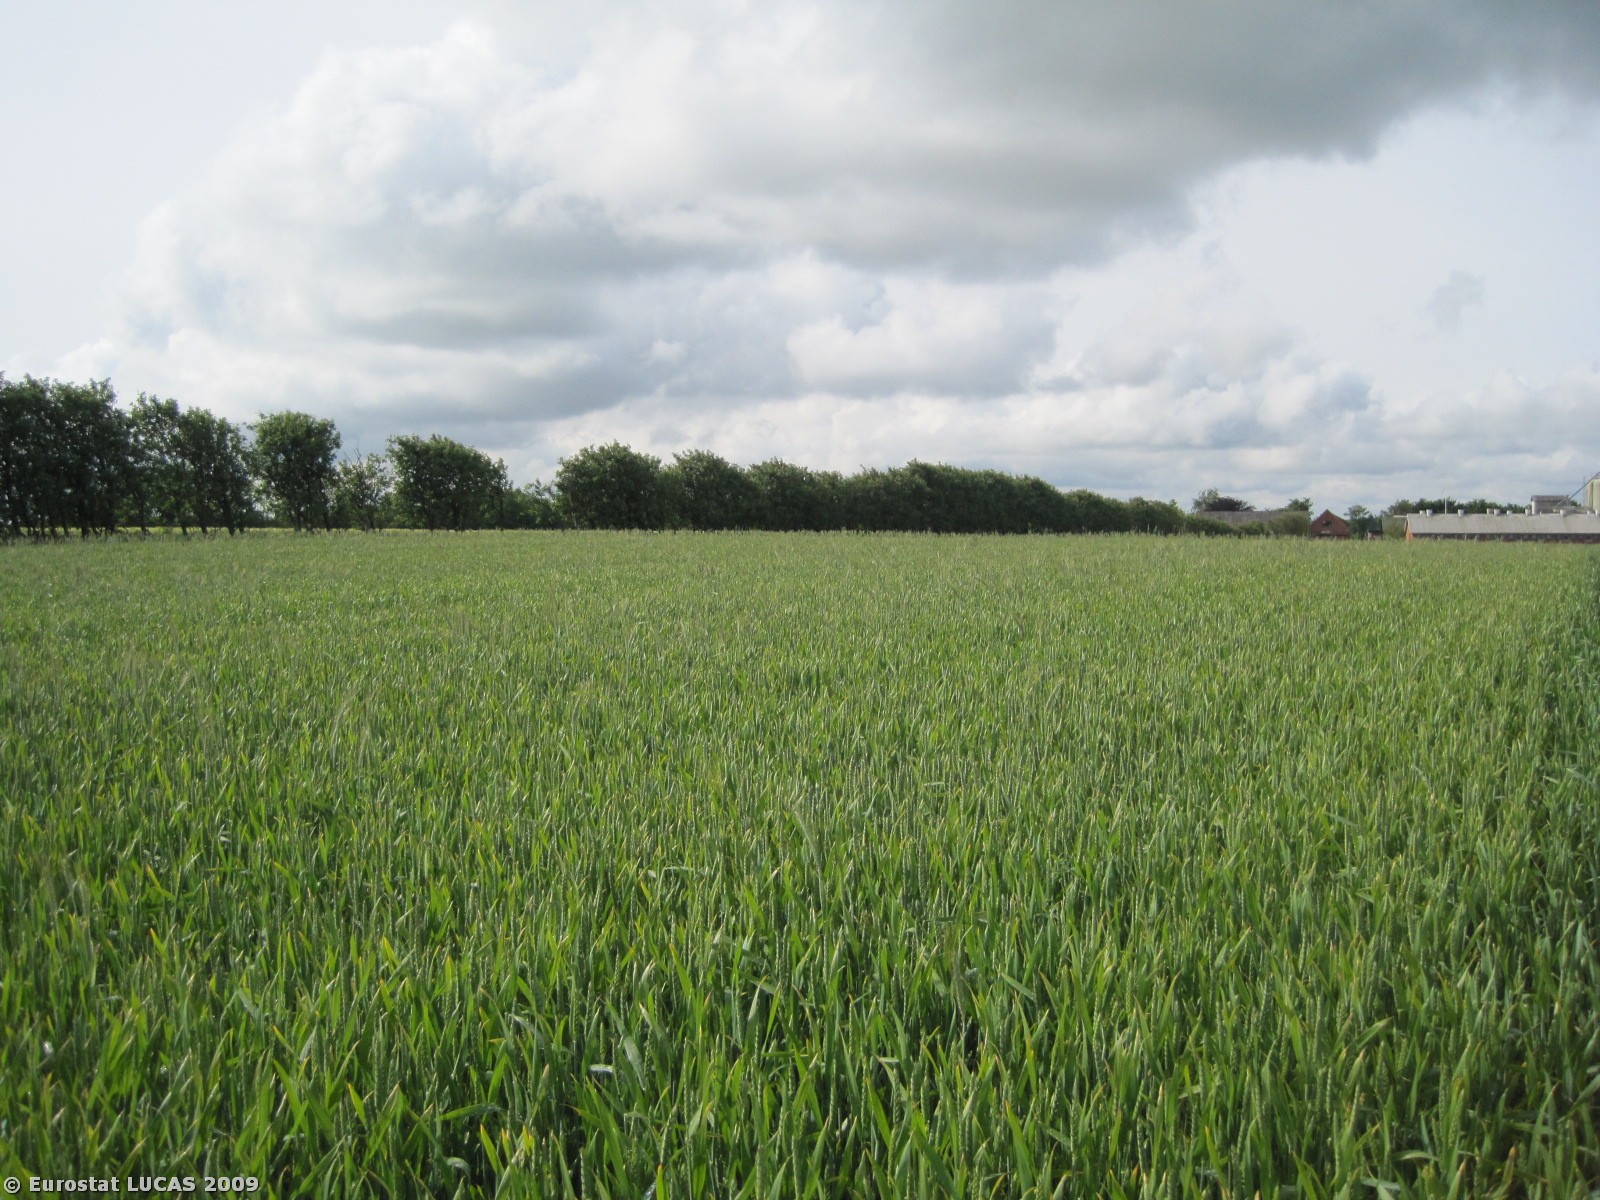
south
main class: Cropland
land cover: Common wheat
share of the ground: > 75 %
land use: Agriculture (excluding fallow land and kitchen gardens)
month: June
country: DK
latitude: 57.3203
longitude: 10.0497
